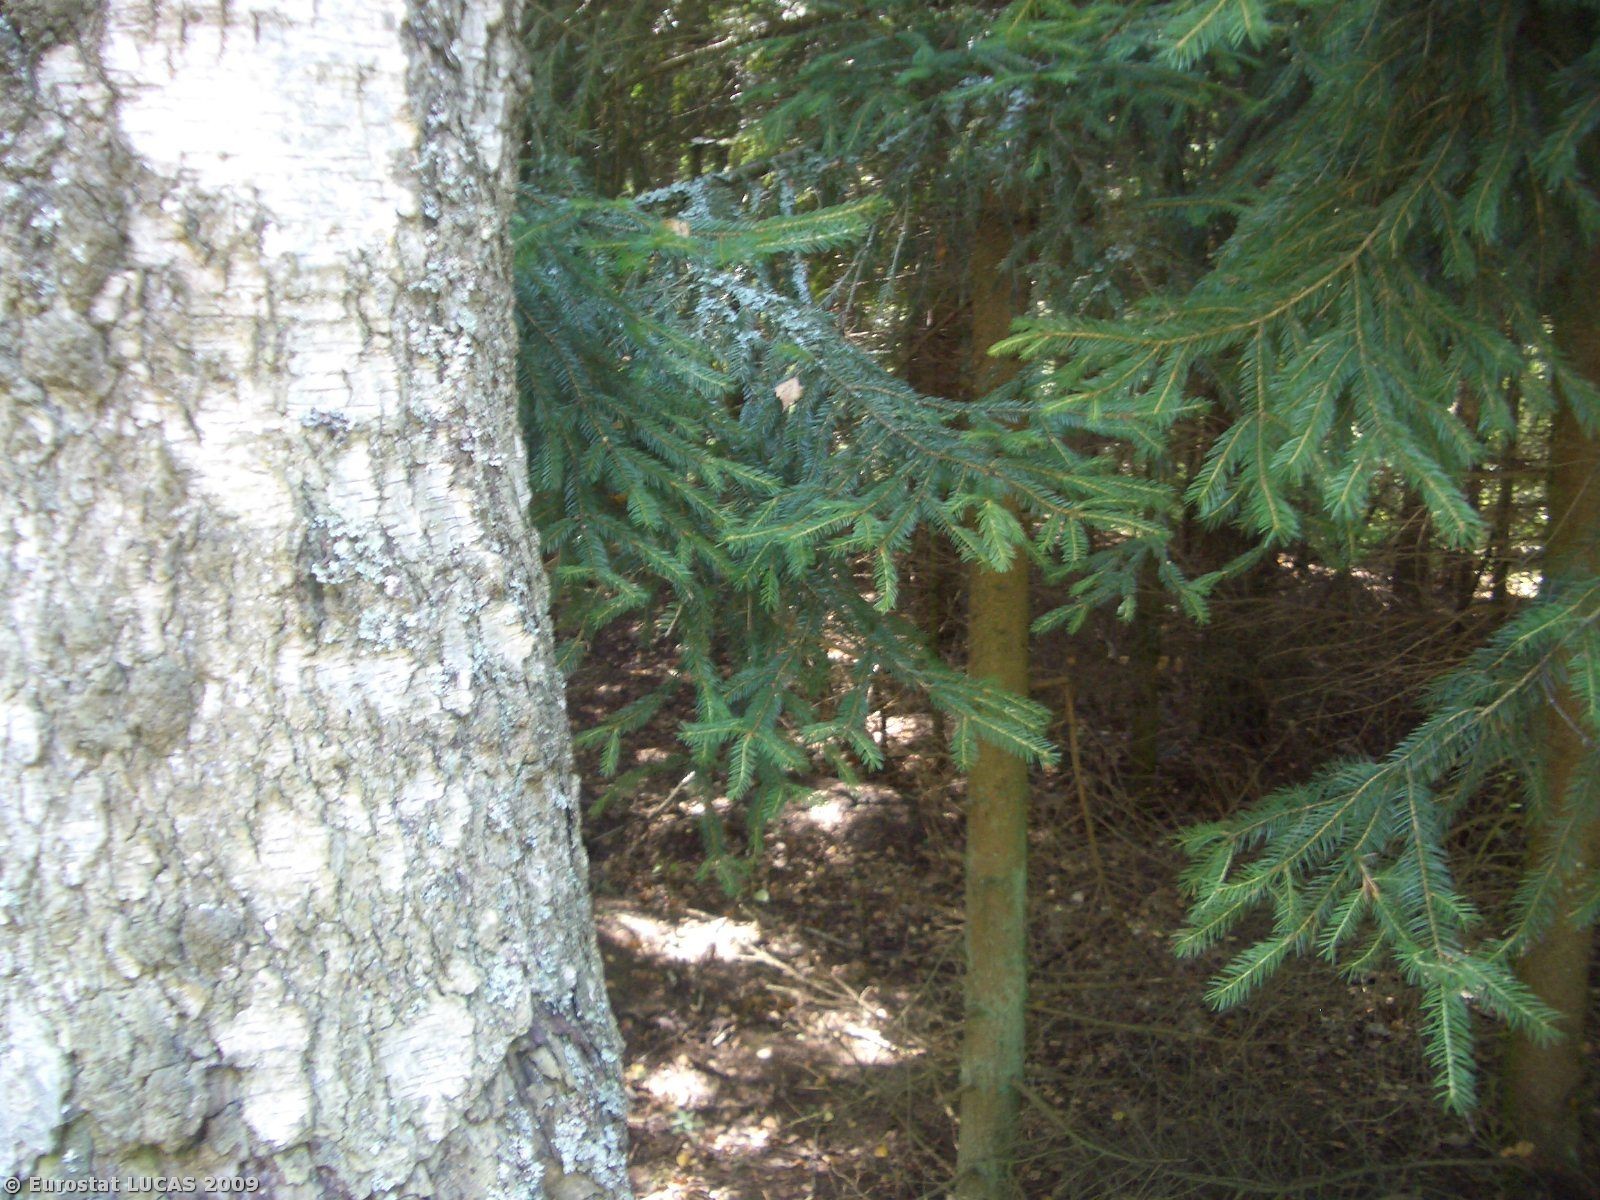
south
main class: Woodland
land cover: Mixed woodland
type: hemiboreal forest and nemoral coniferous forest and mixed broadleaved-coniferous forest
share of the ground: > 75 %
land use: Forestry
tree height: > 5 m
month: July
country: PL
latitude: 51.5177
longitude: 23.1193
